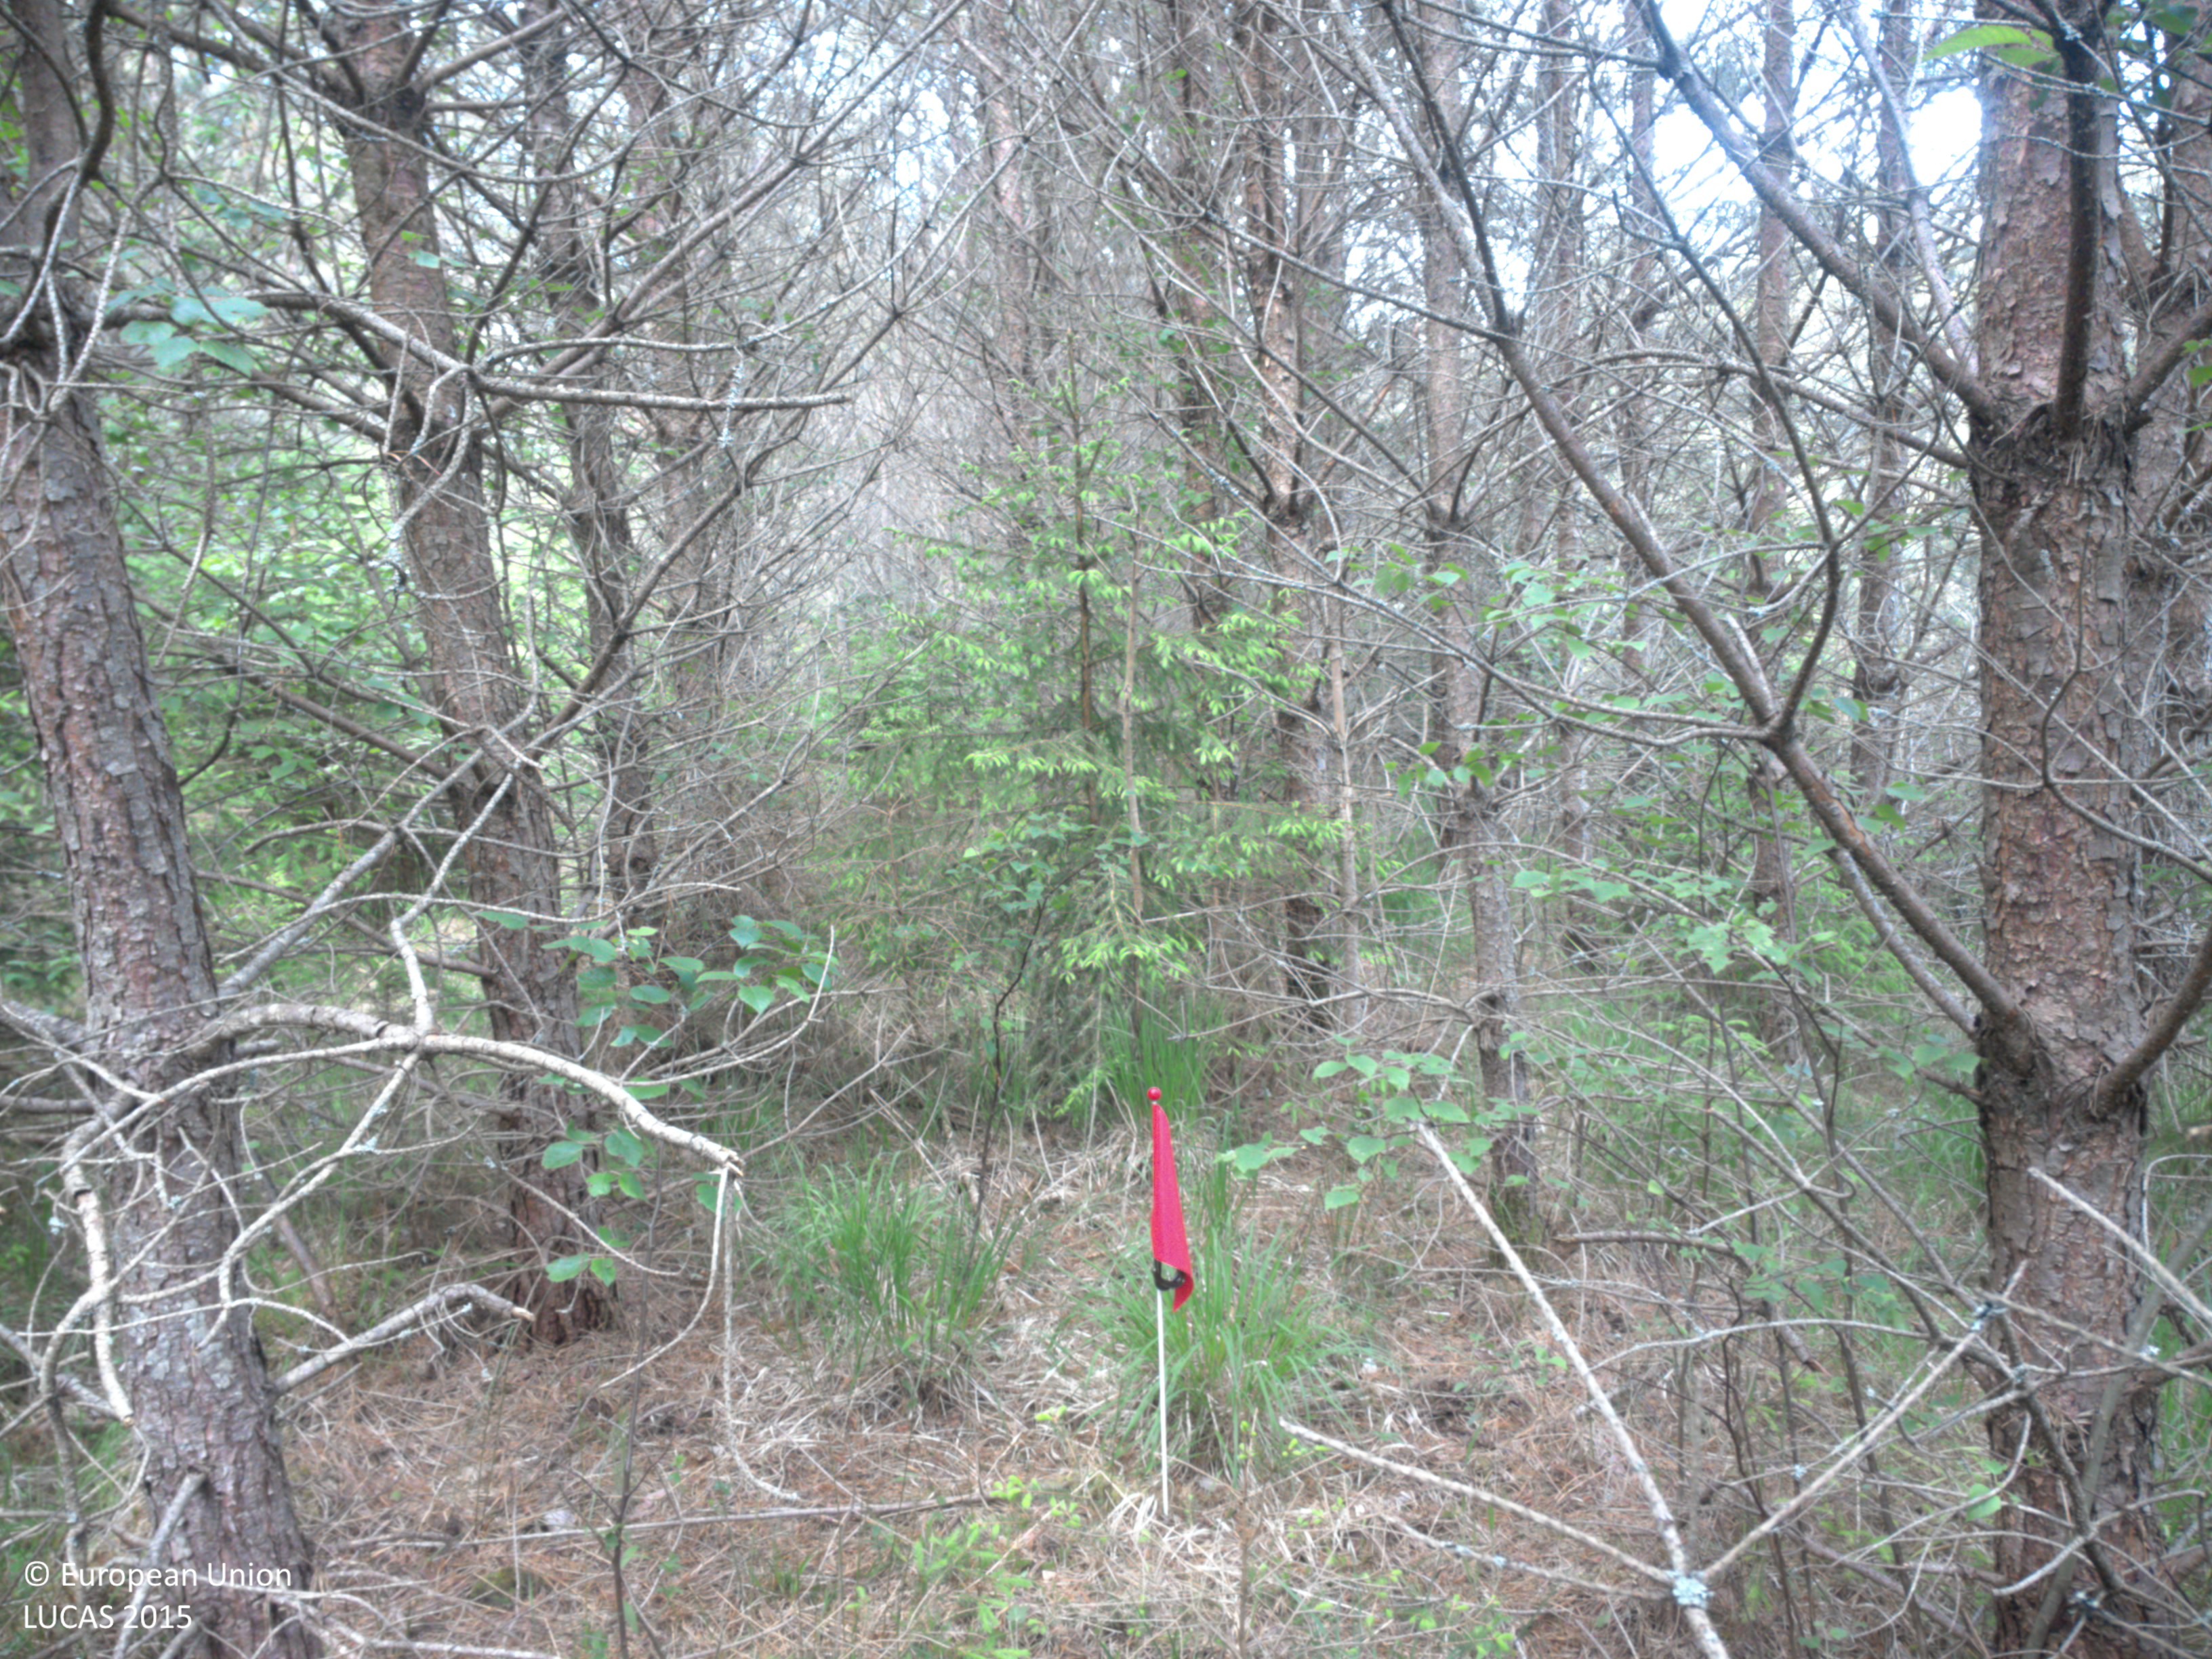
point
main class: Woodland
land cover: Pine dominated coniferous woodland
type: boreal forest
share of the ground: > 75 %
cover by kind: coniferous forest trees 80 %, herbaceous plants 10 %, lichens and mosses 10 %
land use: Forestry
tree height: < 5 m
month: June
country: SE
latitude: 58.8216
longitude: 11.6069
